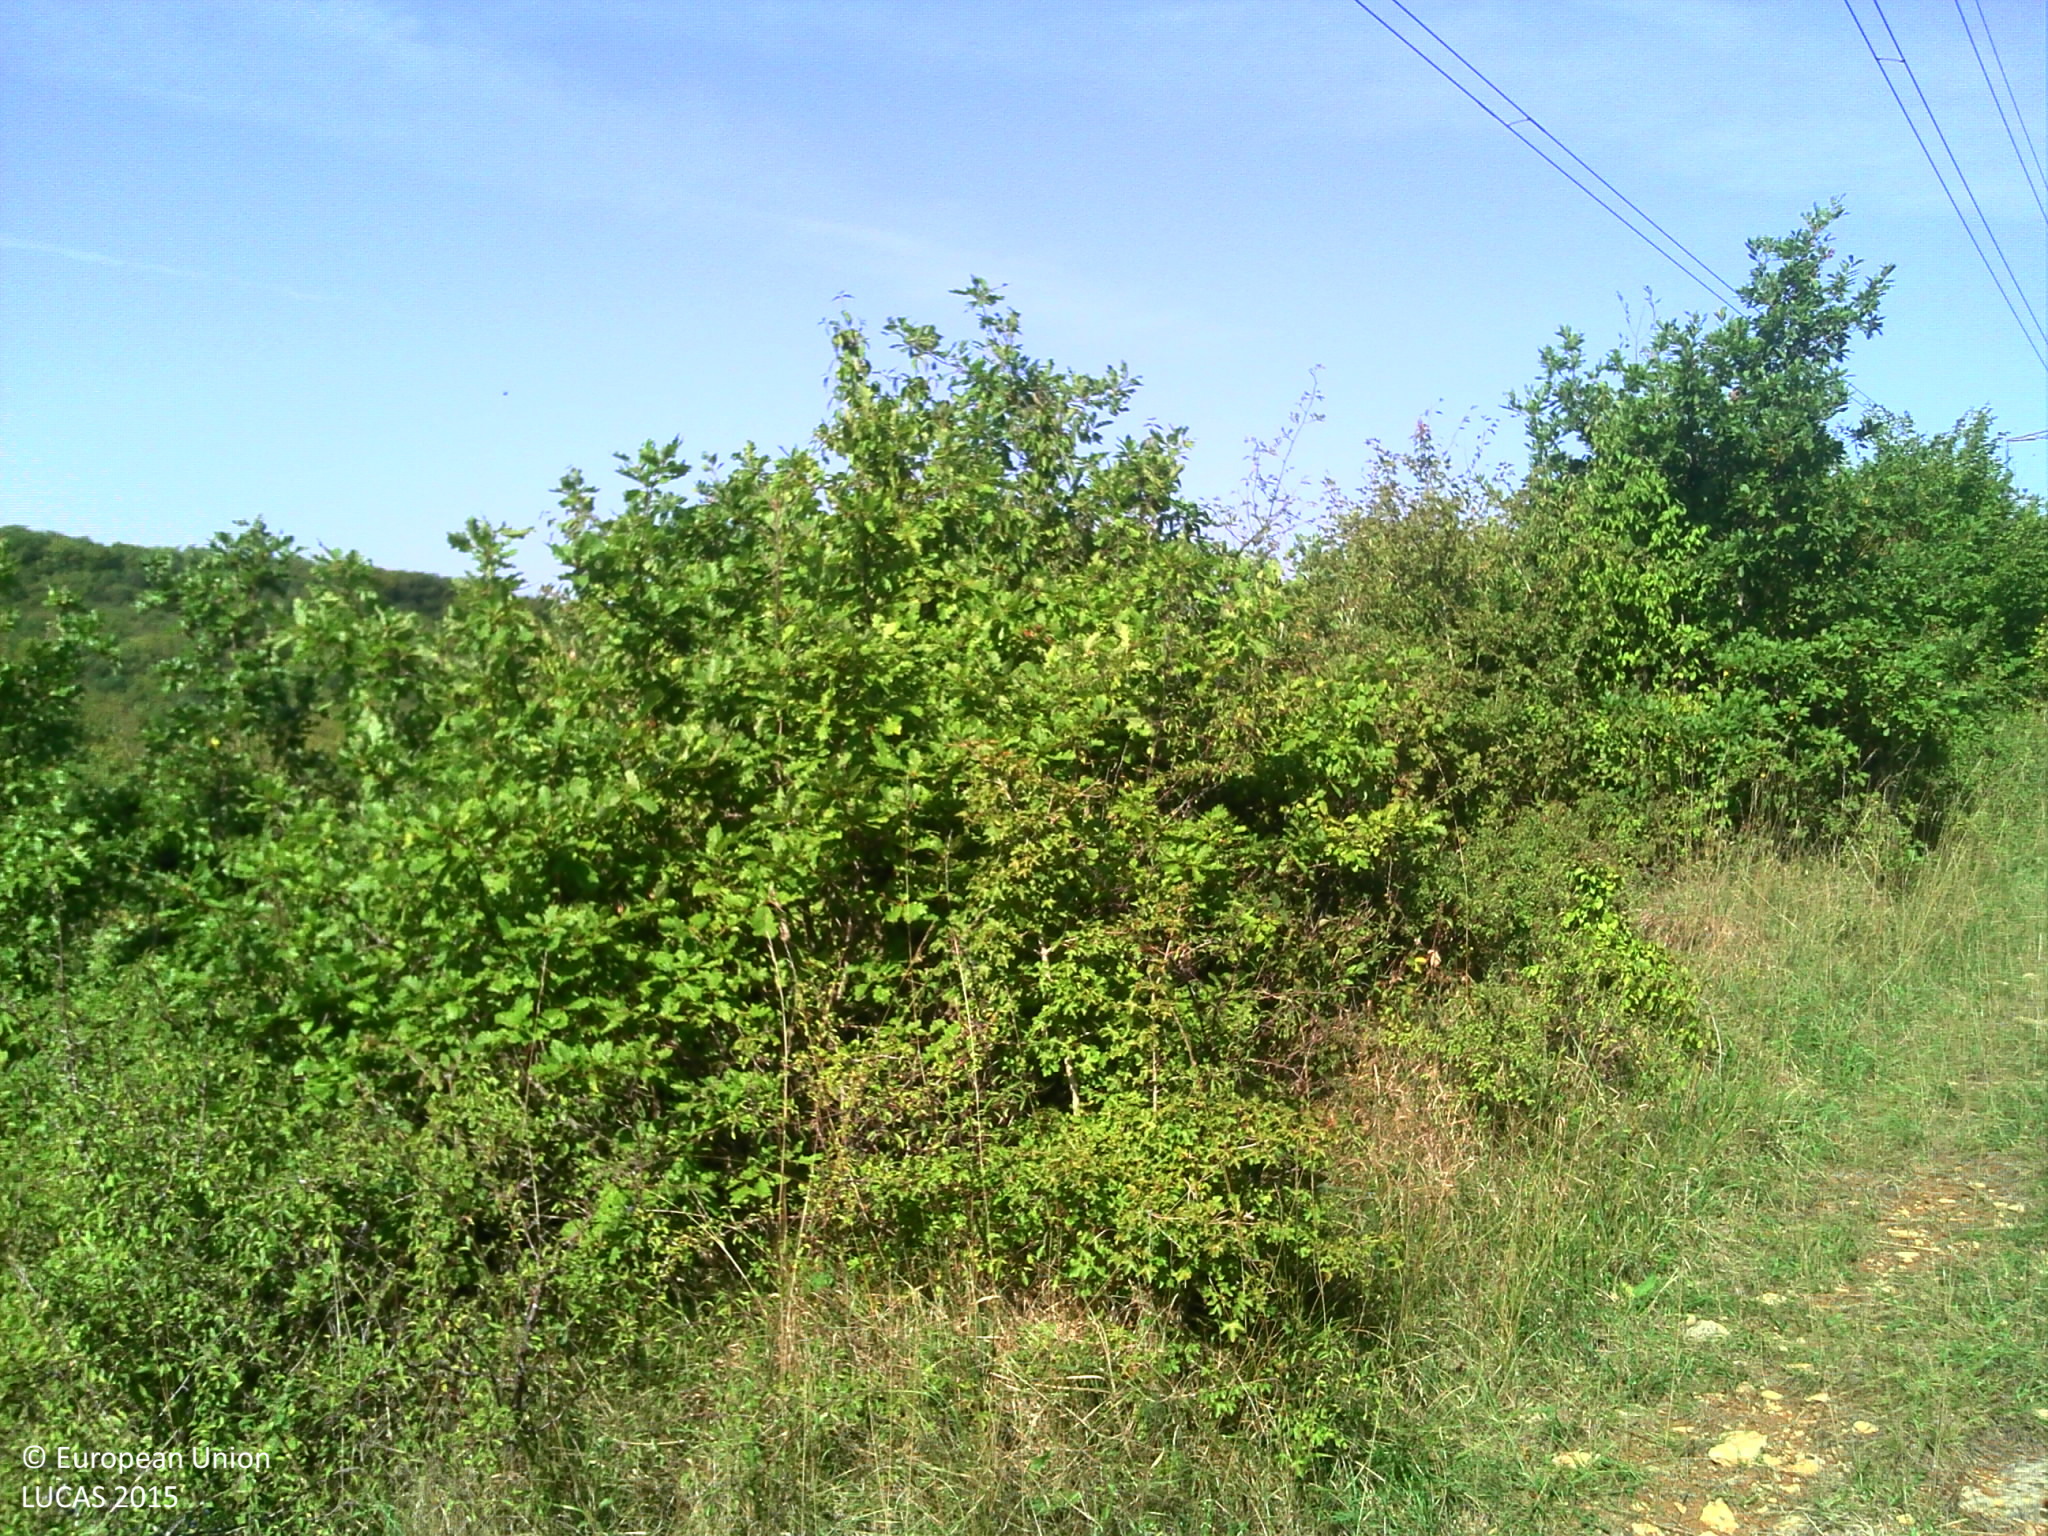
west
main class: Woodland
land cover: Broadleaved woodland
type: mesophytic deciduous forest
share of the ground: > 75 %
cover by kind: broadleaved forest trees 70 %, herbaceous plants 20 %, shrubs 10 %
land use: Semi-natural and natural areas not in use
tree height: < 5 m
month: August
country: FR
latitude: 47.2369
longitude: 4.8354
